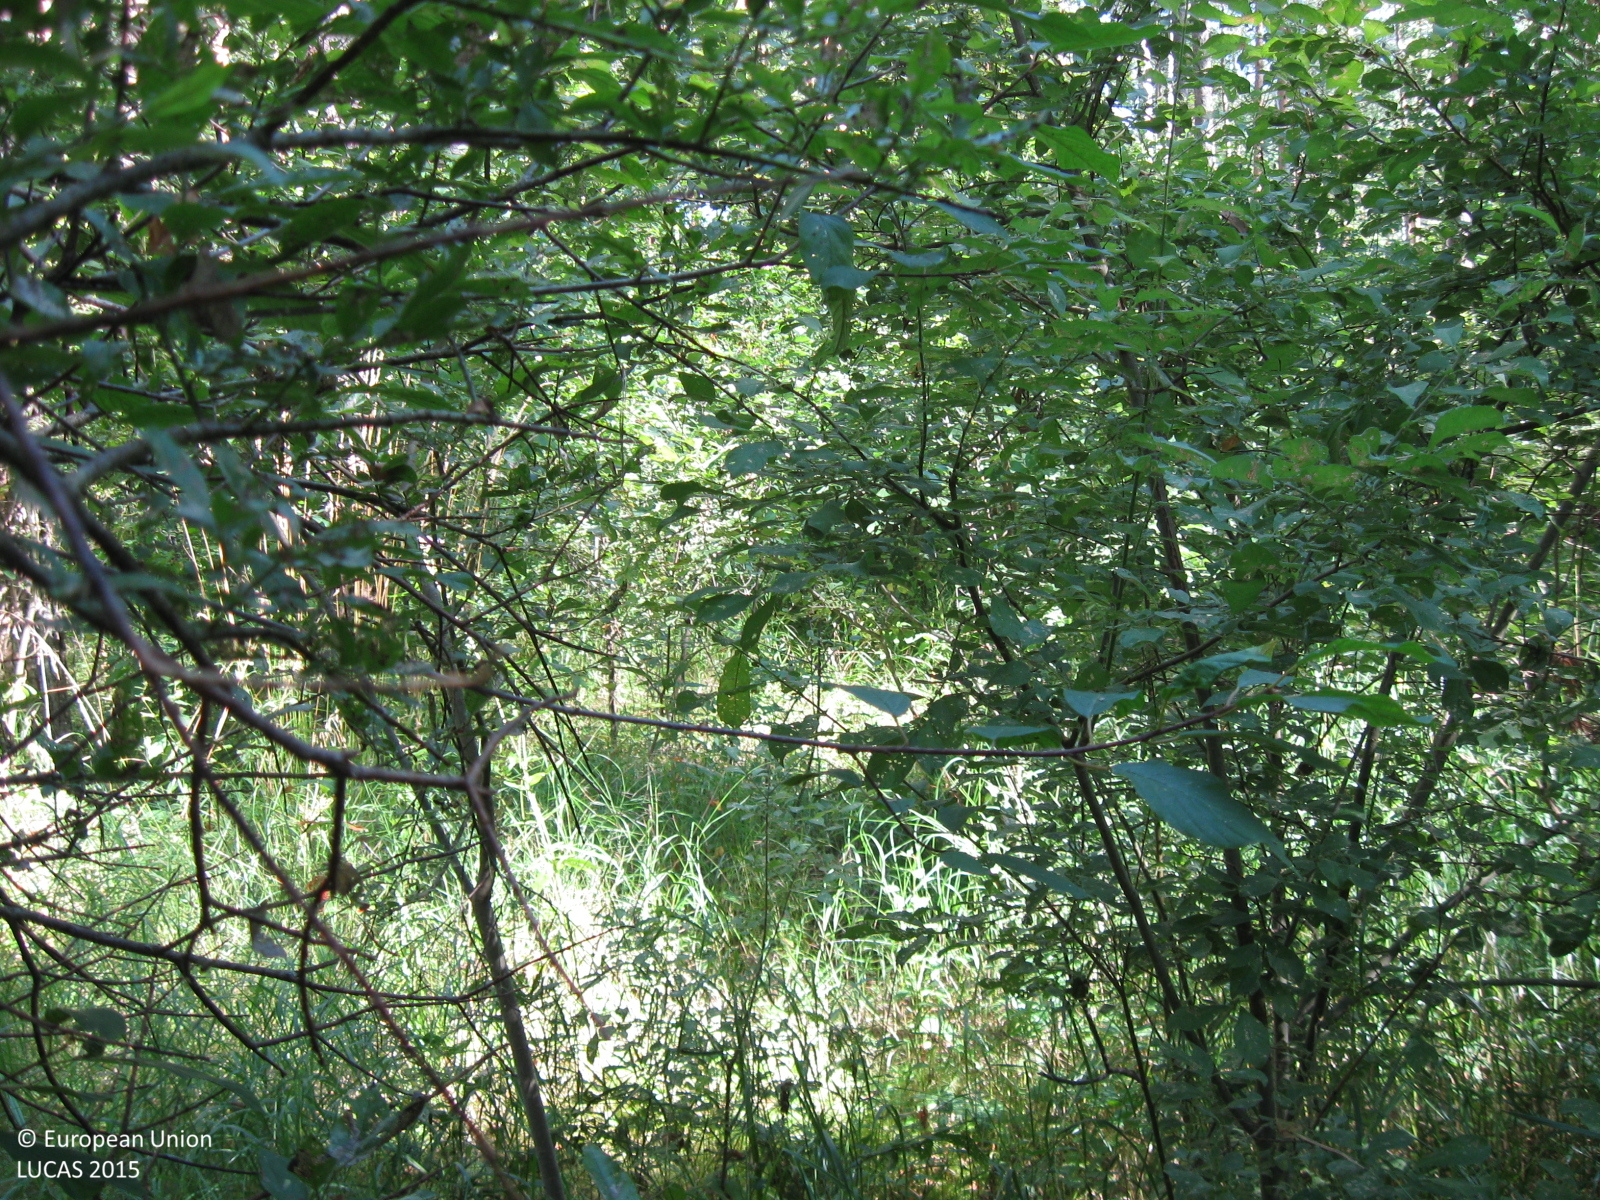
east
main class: Woodland
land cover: Pine dominated mixed woodland
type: hemiboreal forest and nemoral coniferous forest and mixed broadleaved-coniferous forest
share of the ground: > 75 %
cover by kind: coniferous forest trees 60 %, broadleaved forest trees 30 %, herbaceous plants 10 %
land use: Forestry
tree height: > 5 m
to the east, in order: Pine dominated mixed woodland; Pine dominated coniferous woodland; Pine dominated mixed woodland; Ditches and canals; Other mixed woodland
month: August
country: LT
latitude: 55.3044
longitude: 22.4583
